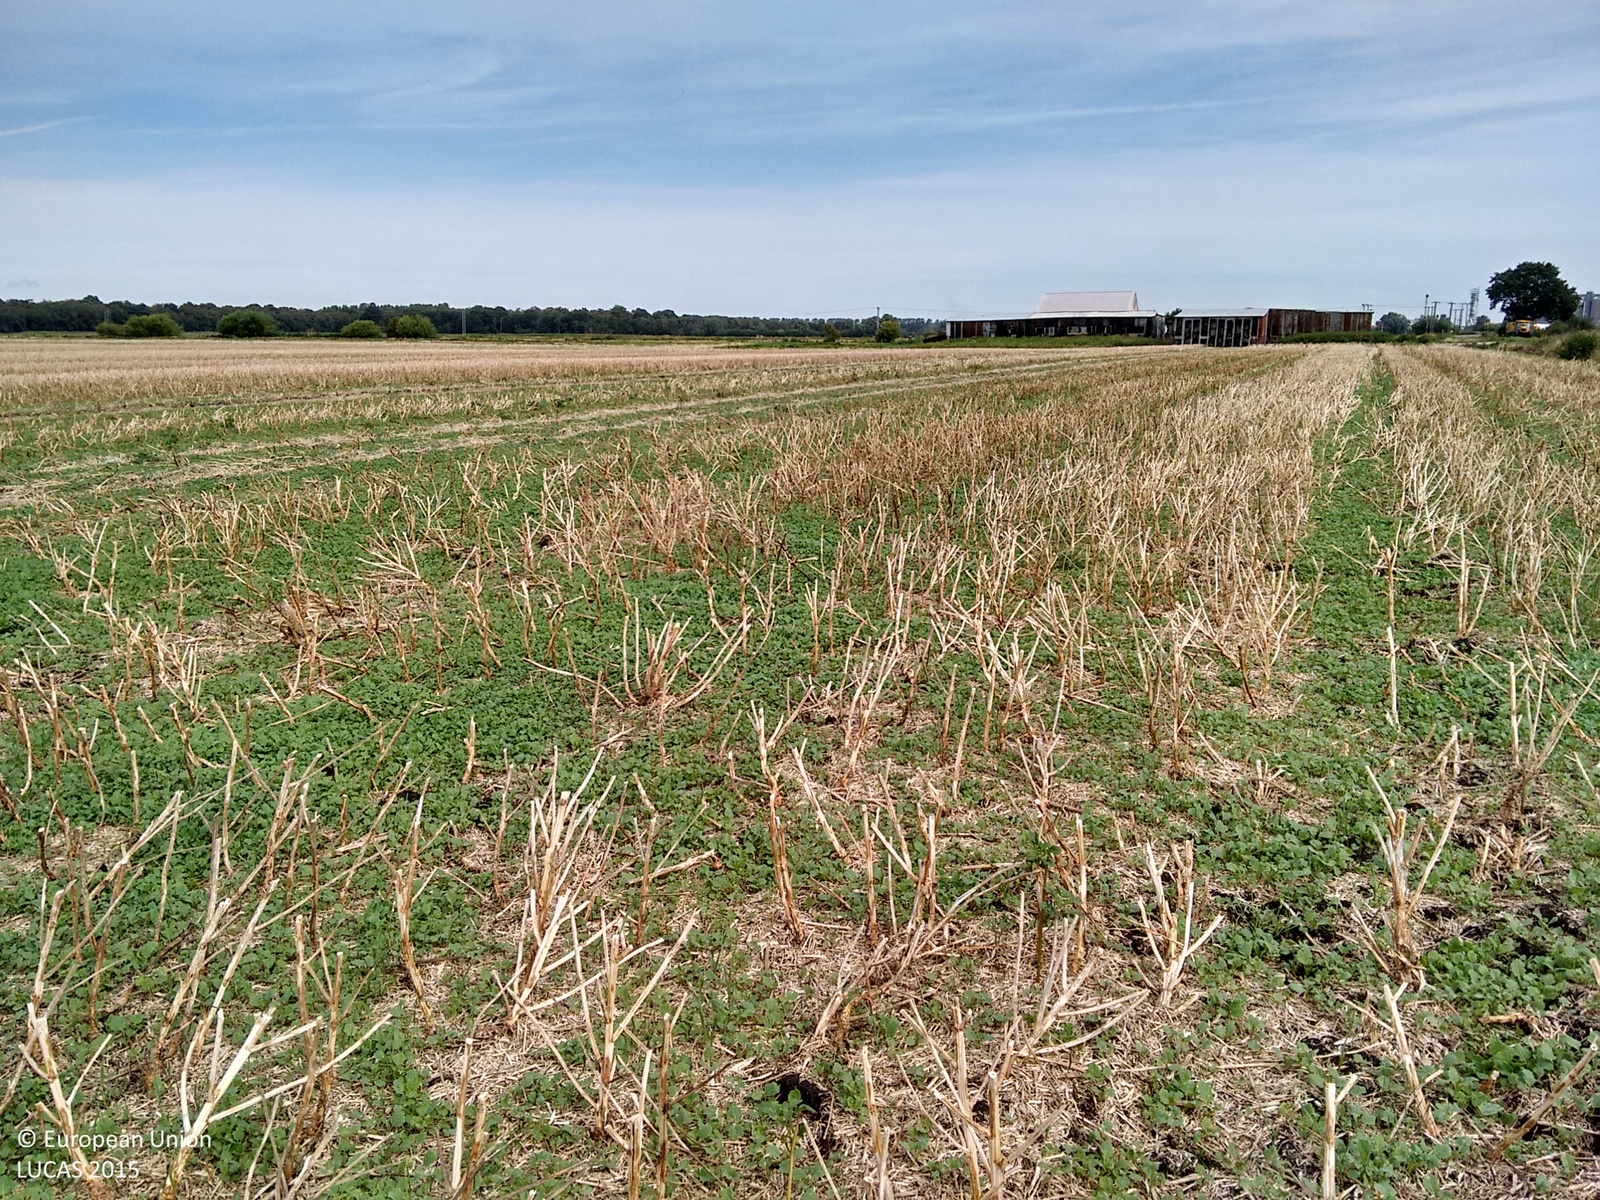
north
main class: Cropland
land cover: Rape and turnip rape
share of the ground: > 75 %
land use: Agriculture (excluding fallow land and kitchen gardens)
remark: Harvested field
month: August
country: GB
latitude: 52.5336
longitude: 0.4338
